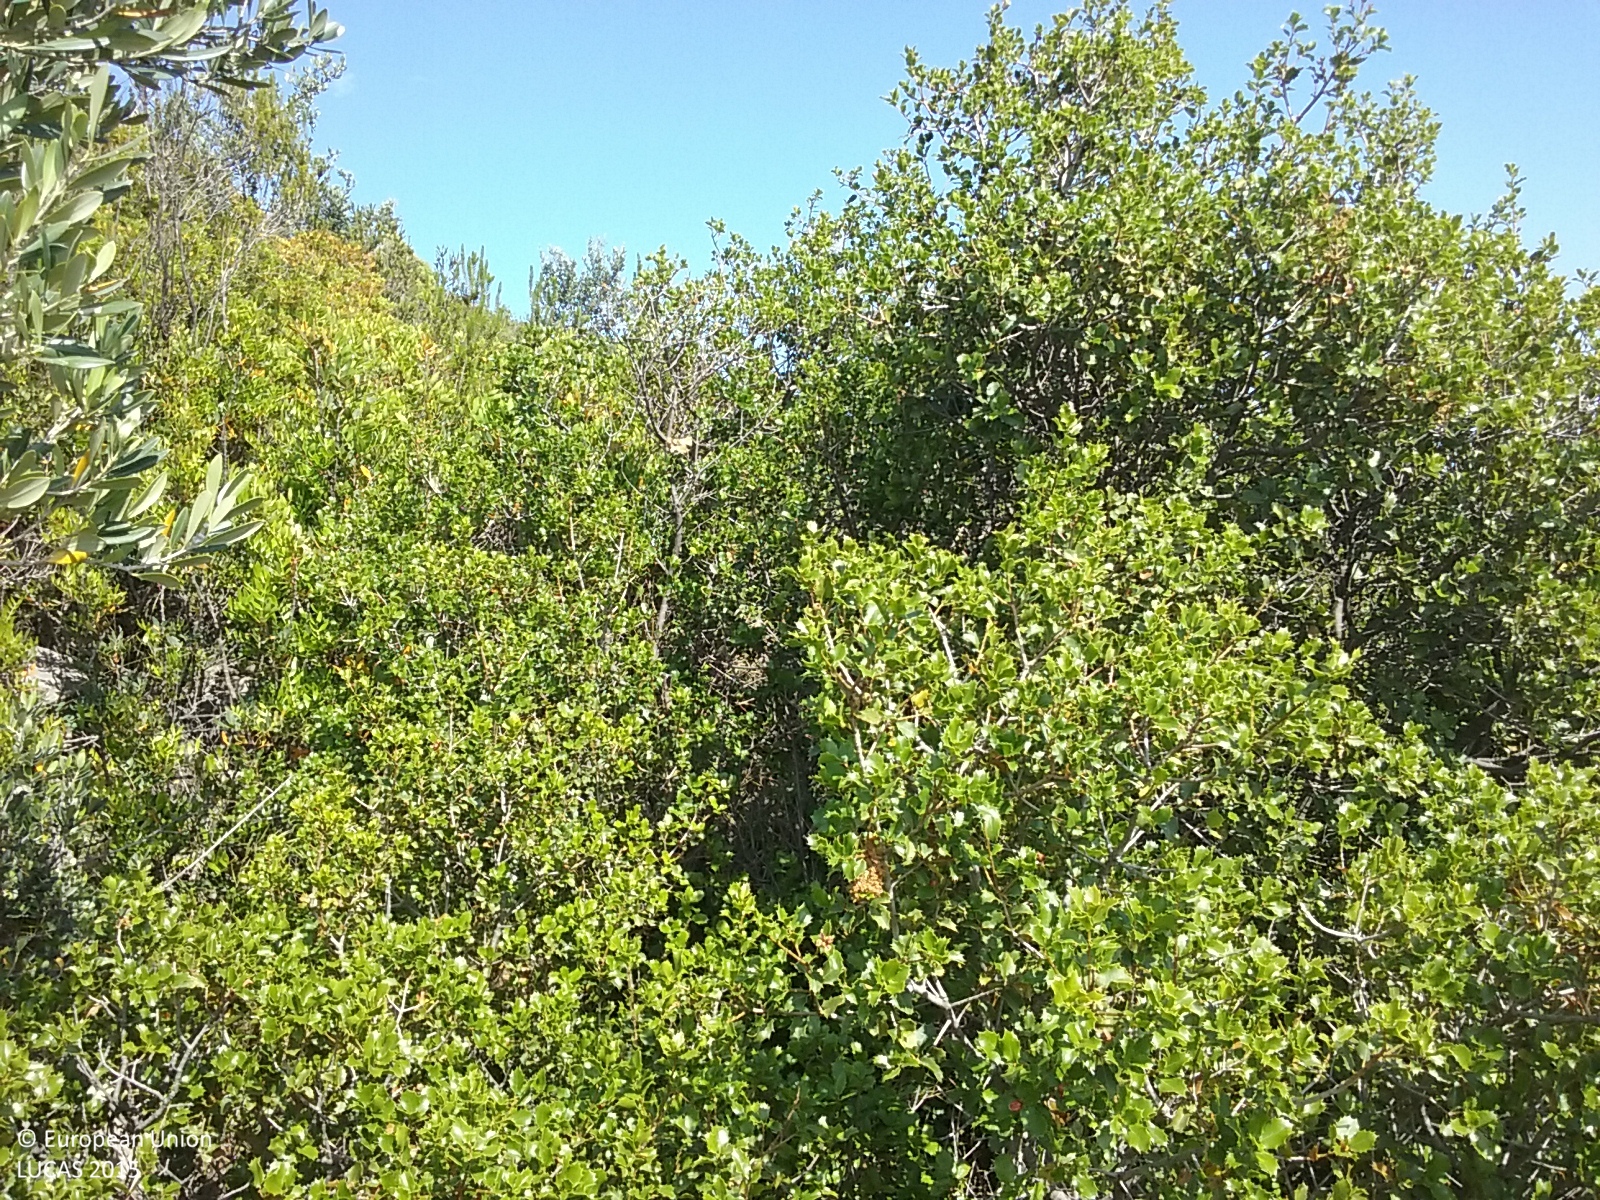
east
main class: Shrubland
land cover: Shrubland with sparse tree cover
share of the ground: > 75 %
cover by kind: shrubs 70 %, herbaceous plants 20 %, broadleaved forest trees 5 %
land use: Semi-natural and natural areas not in use
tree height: < 5 m
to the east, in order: Shrubland with sparse tree cover
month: May
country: ES
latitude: 40.2666
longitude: 0.0131
